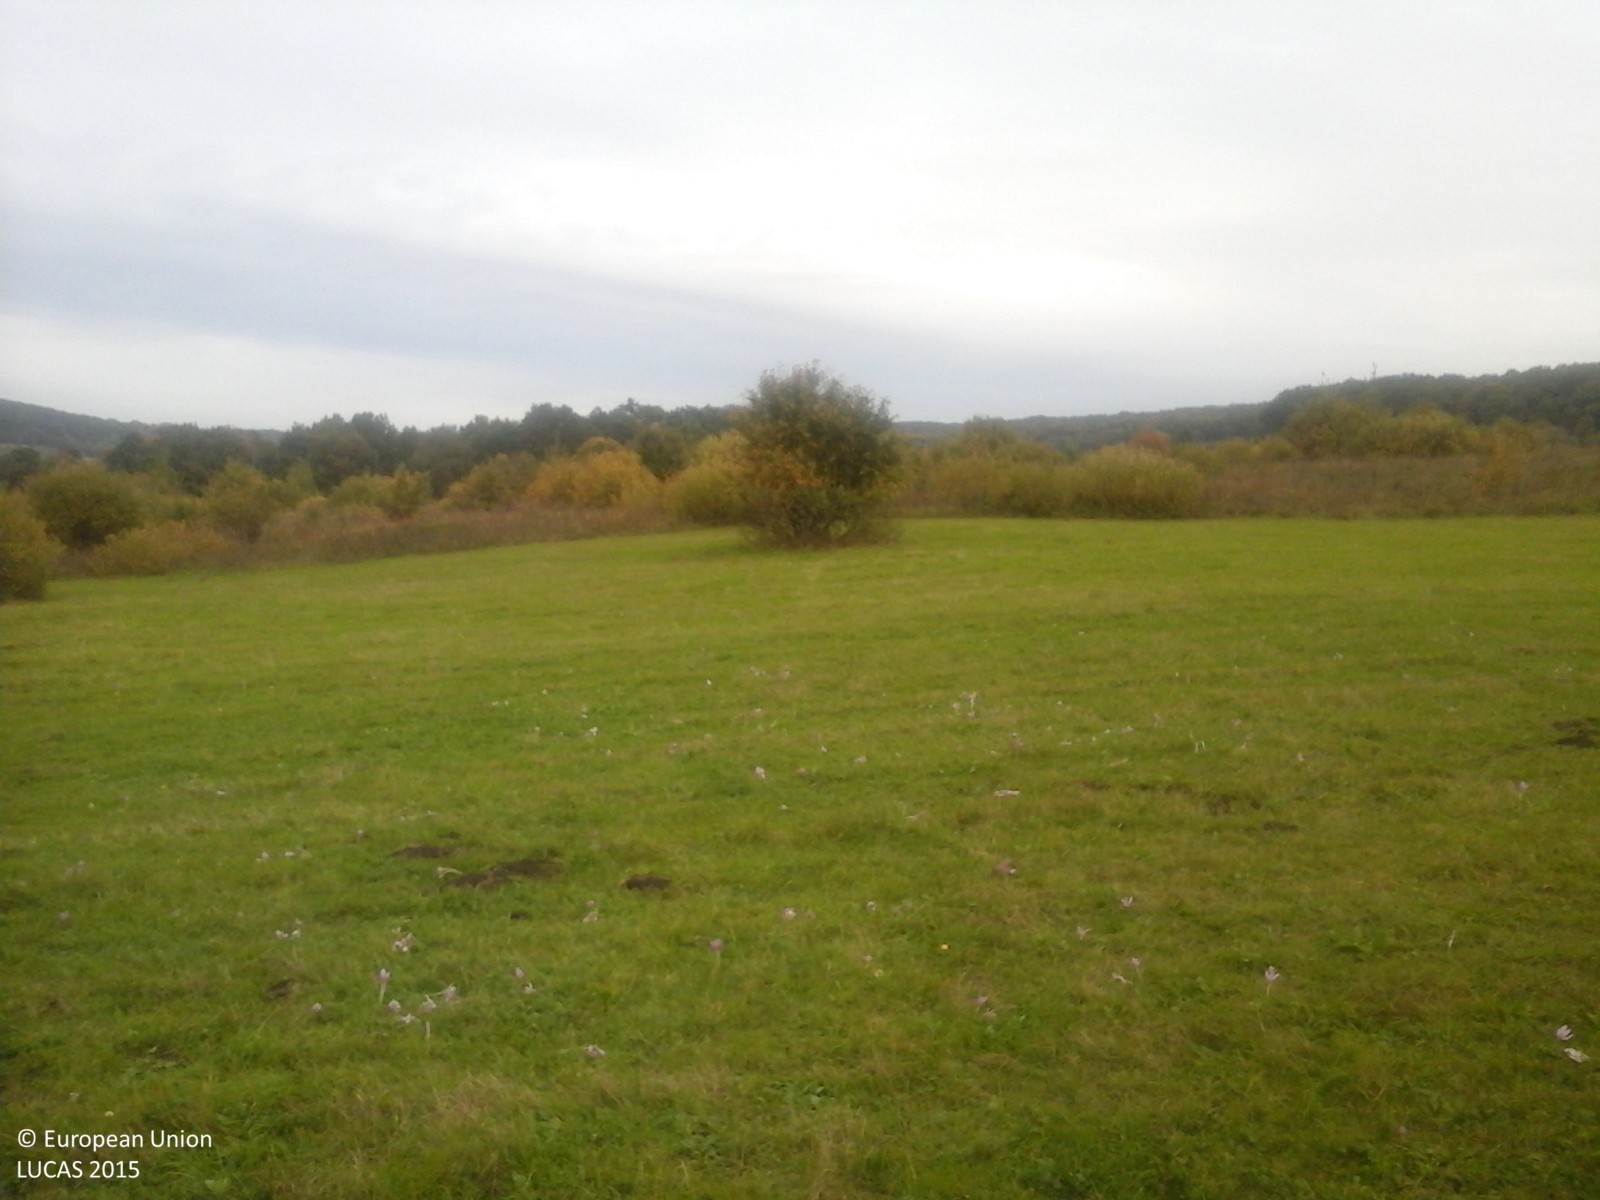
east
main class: Grassland
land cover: Grassland without tree/shrub cover
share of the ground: > 75 %
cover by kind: herbaceous plants 100 %
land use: Agriculture (excluding fallow land and kitchen gardens)
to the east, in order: Grassland without tree/shrub cover; Shrubland with sparse tree cover; Grassland without tree/shrub cover; Shrubland with sparse tree cover; Grassland with sparse tree/shrub cover; Broadleaved woodland
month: October
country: RO
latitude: 45.9817
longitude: 24.8707
